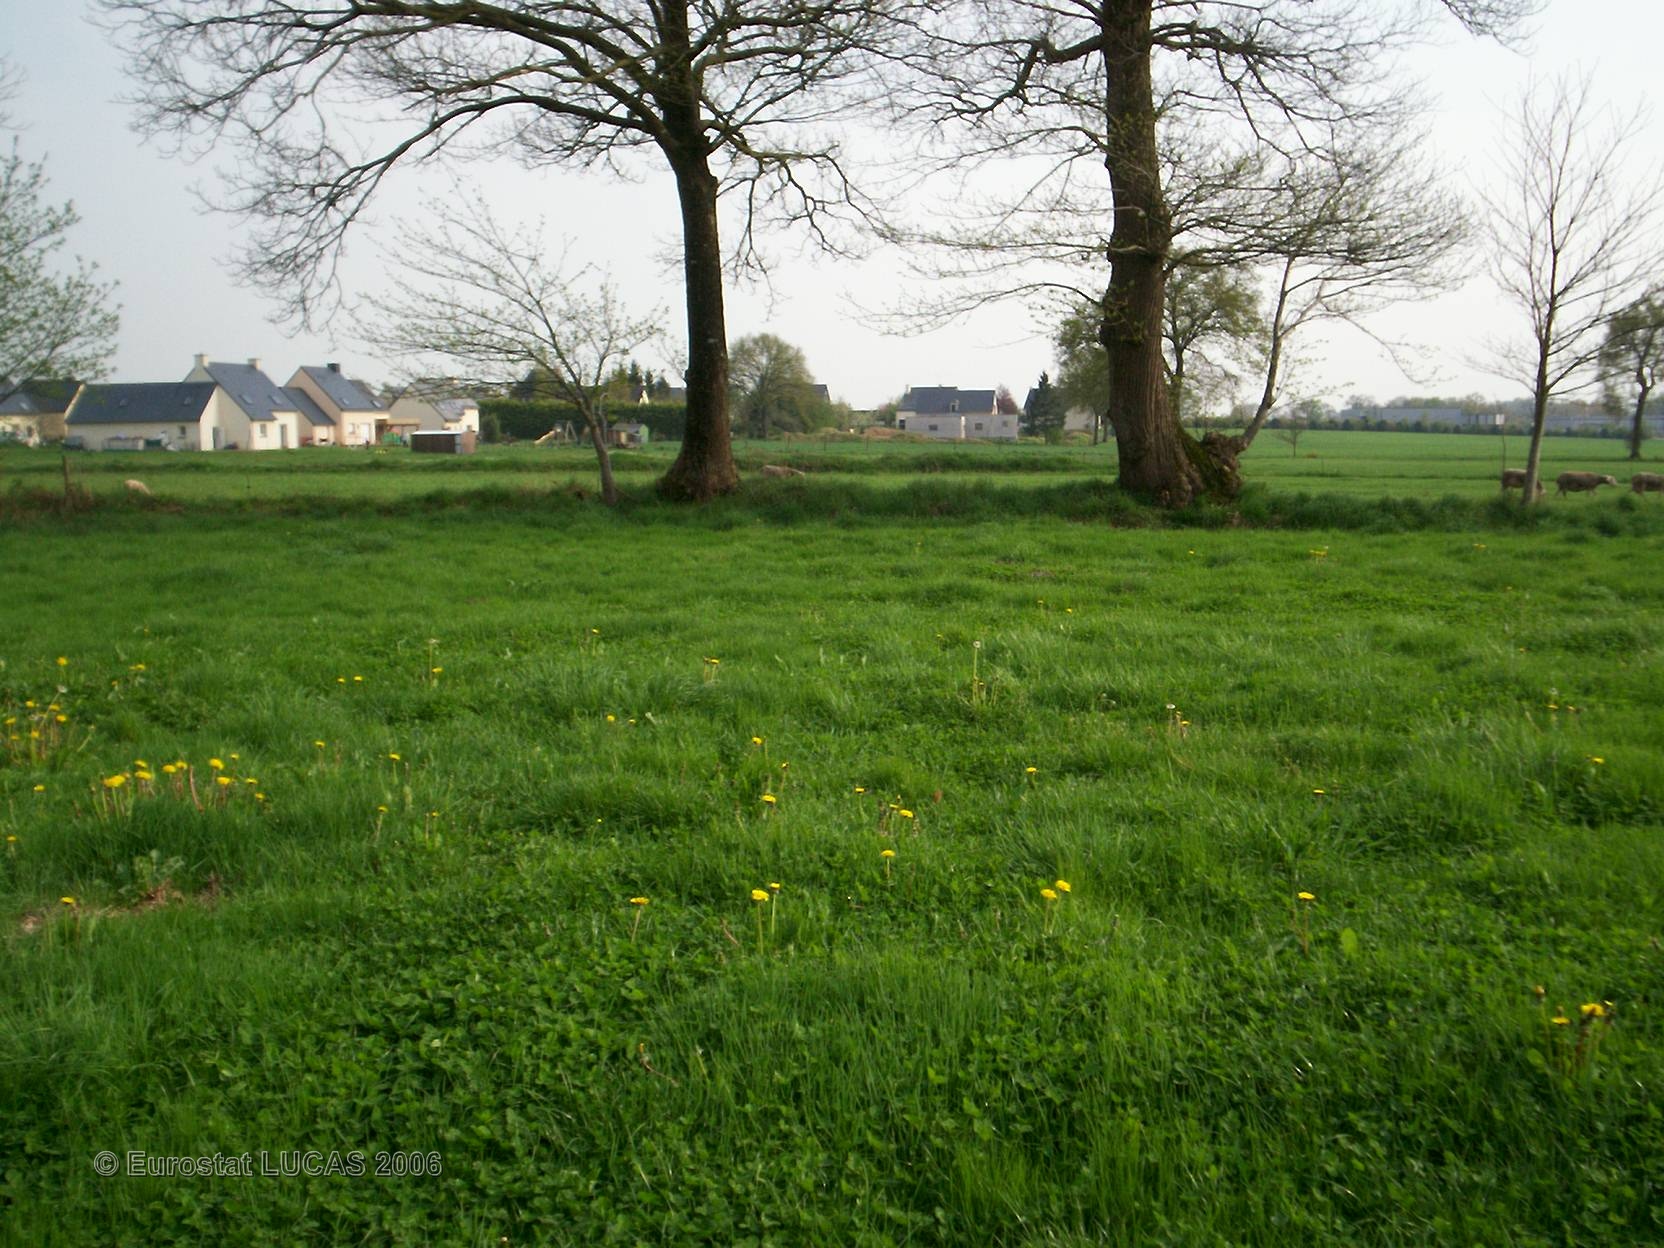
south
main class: Grassland
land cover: Grassland without tree/shrub cover
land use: Agriculture (excluding fallow land and kitchen gardens)
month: April
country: FR
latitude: 48.1444
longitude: -1.3468
